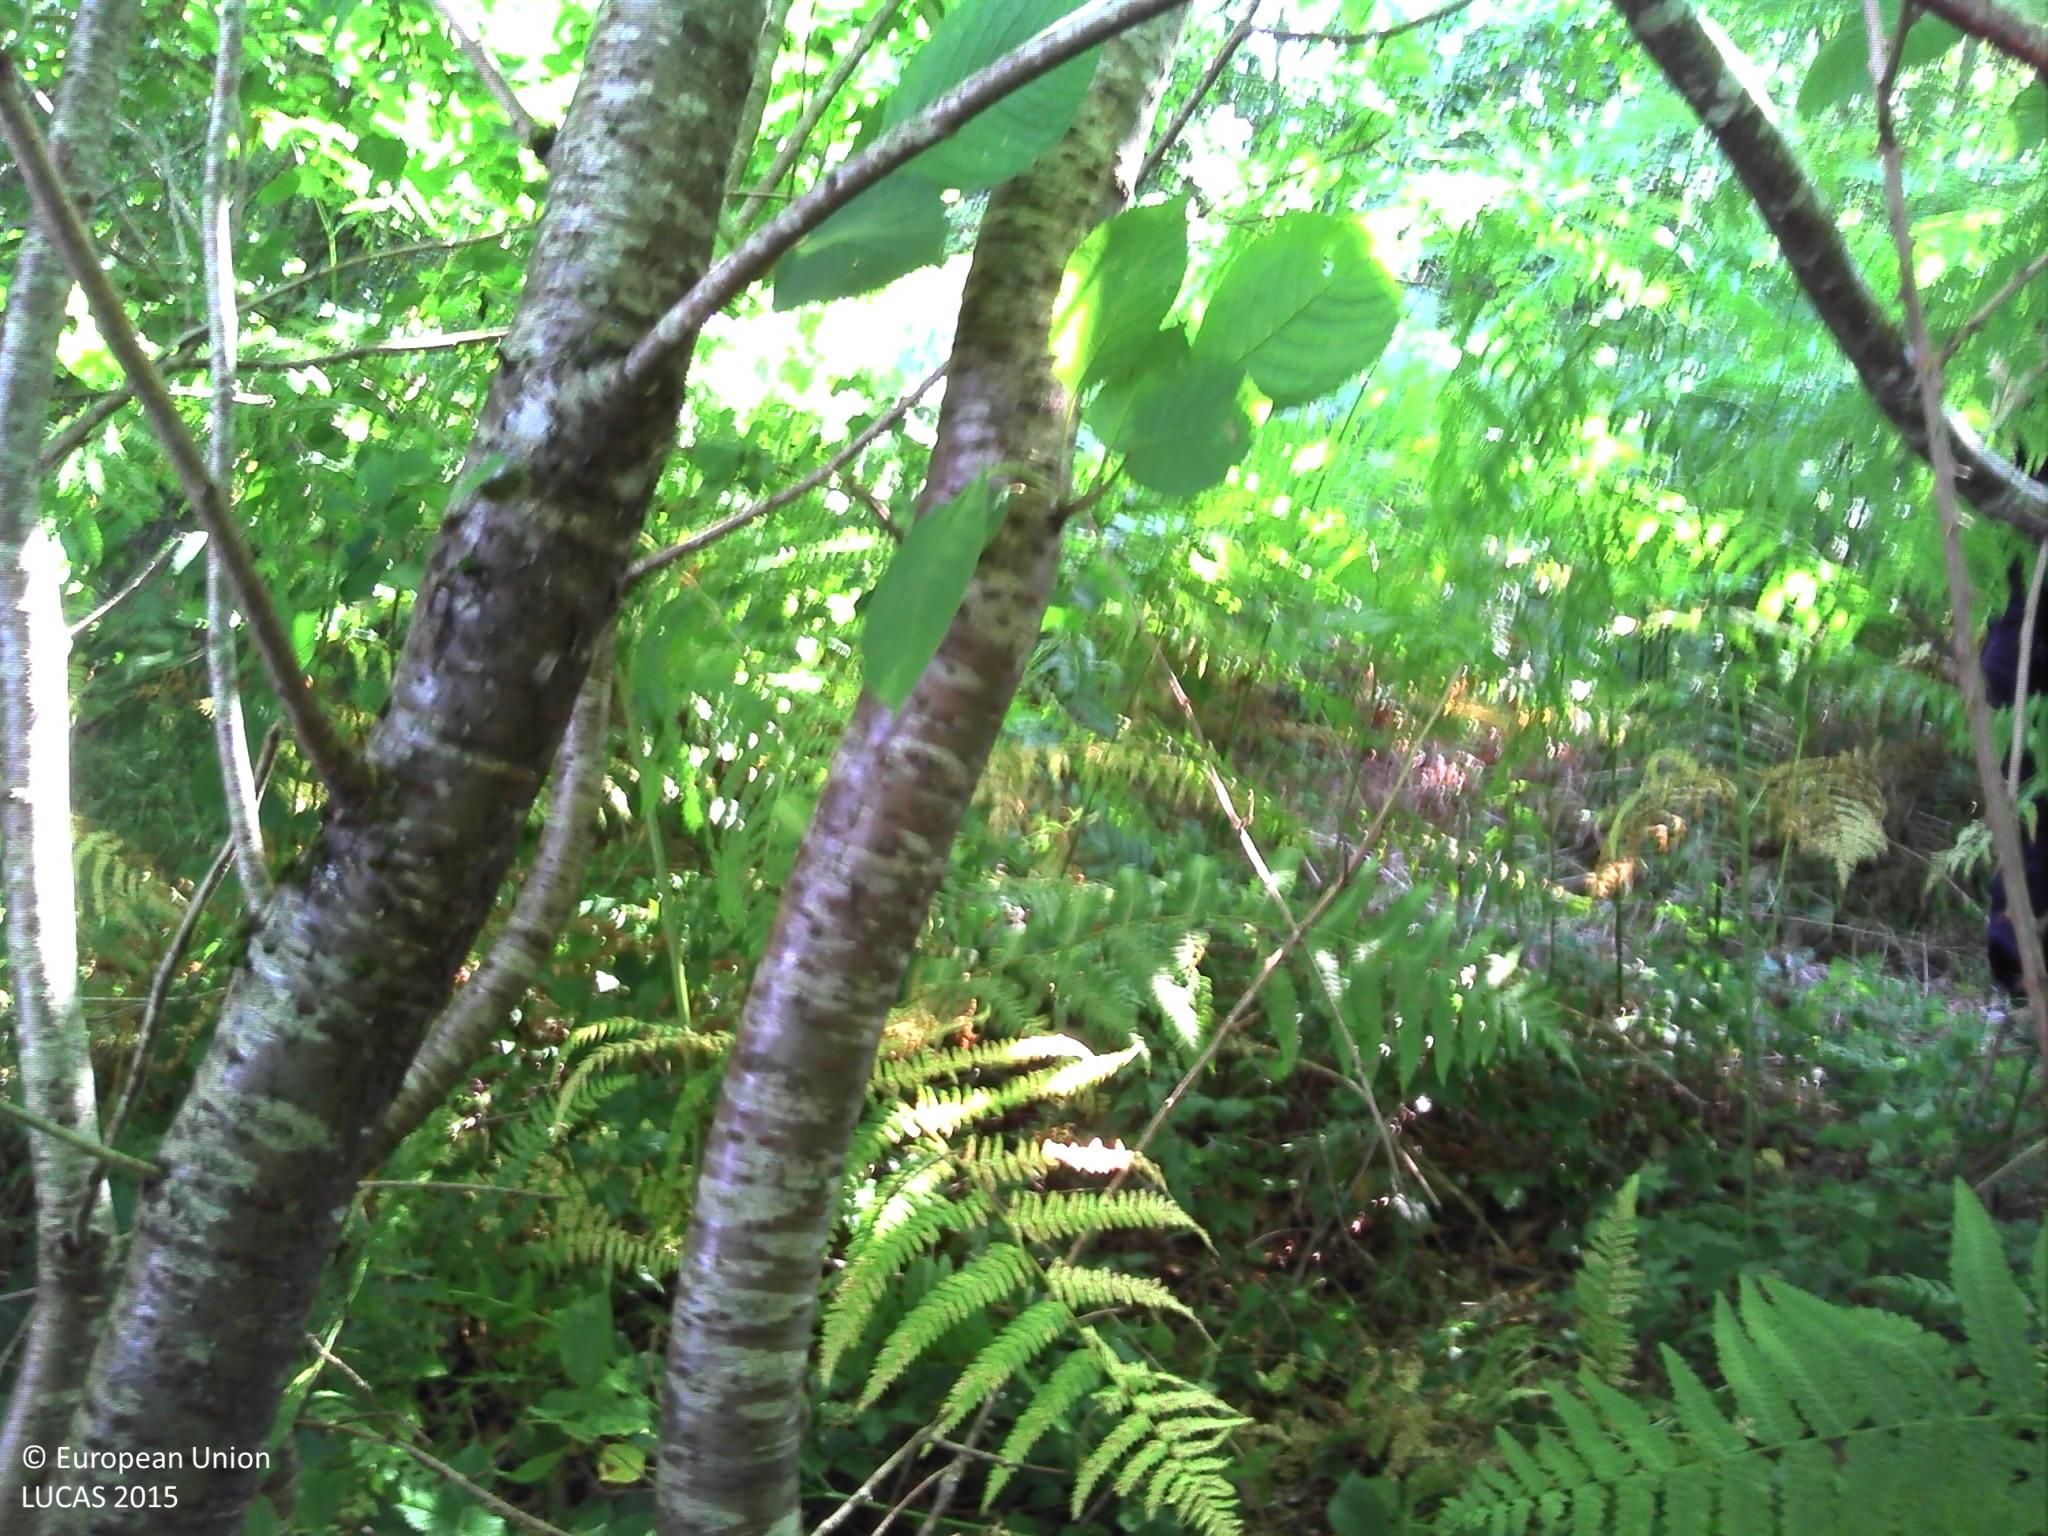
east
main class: Woodland
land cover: Broadleaved woodland
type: acidophilous oak and oak-birch forest
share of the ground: > 75 %
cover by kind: broadleaved forest trees 90 %, shrubs 5 %, herbaceous plants 5 %
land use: Forestry
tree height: > 5 m
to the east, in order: Broadleaved woodland; Shrubland without tree cover; Spruce dominated mixed woodland; Tracks; Fences; Other bare soil; Fences; Broadleaved woodland; Tracks; Rye
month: July
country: FR
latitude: 46.0856
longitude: 1.2864
